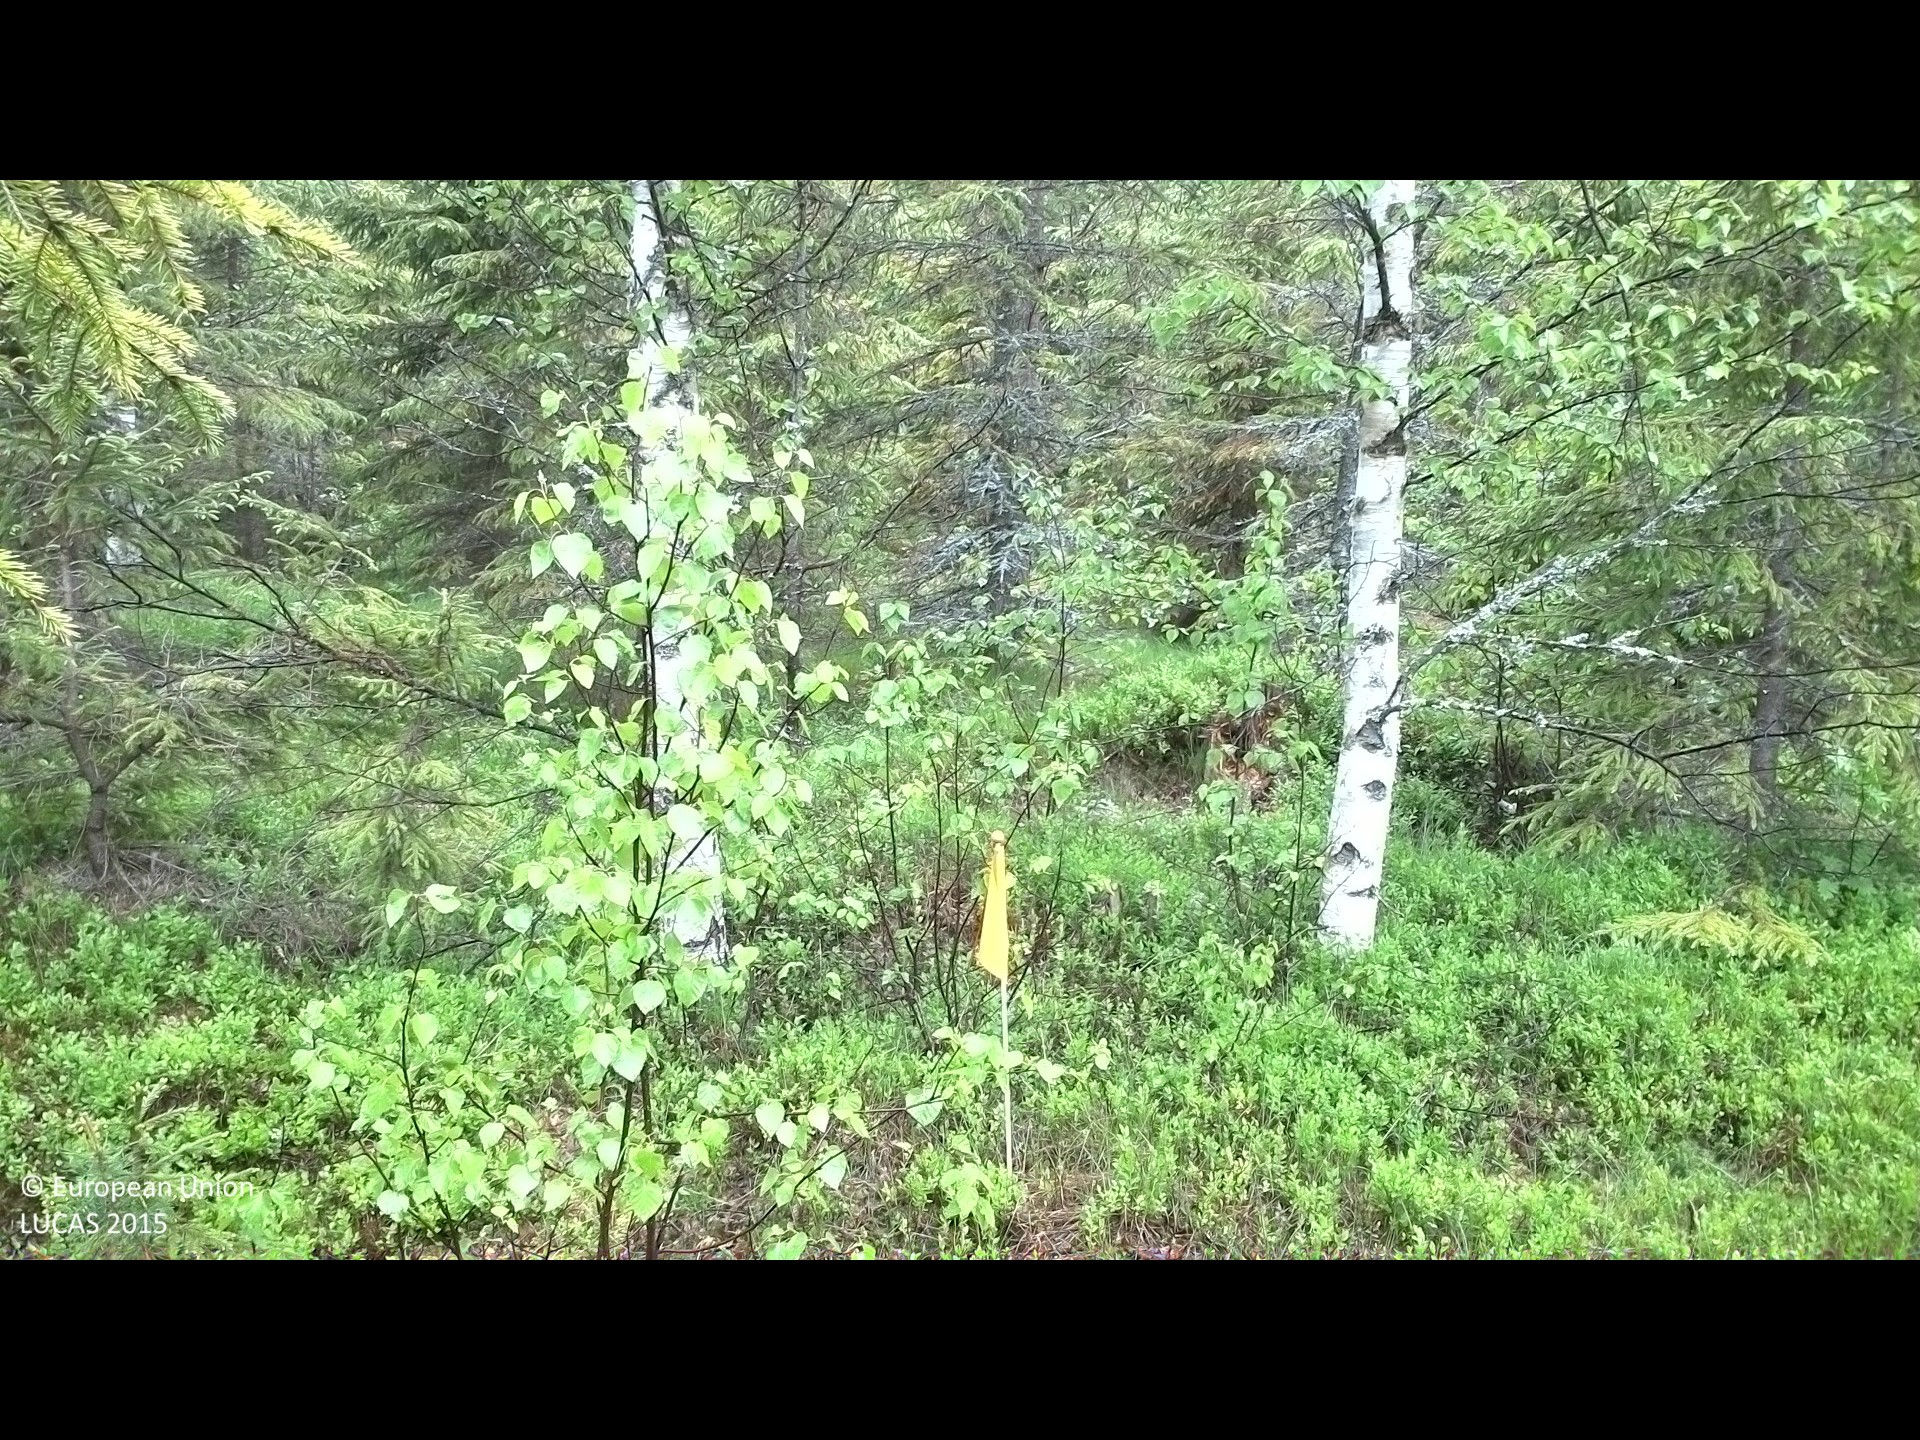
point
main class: Woodland
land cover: Spruce dominated mixed woodland
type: boreal forest
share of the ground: 25 - 50 %
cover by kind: shrubs 50 %, coniferous forest trees 25 %, broadleaved forest trees 15 %, lichens and mosses 10 %
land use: Forestry
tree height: > 5 m
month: June
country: SE
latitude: 62.1532
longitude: 17.1395
